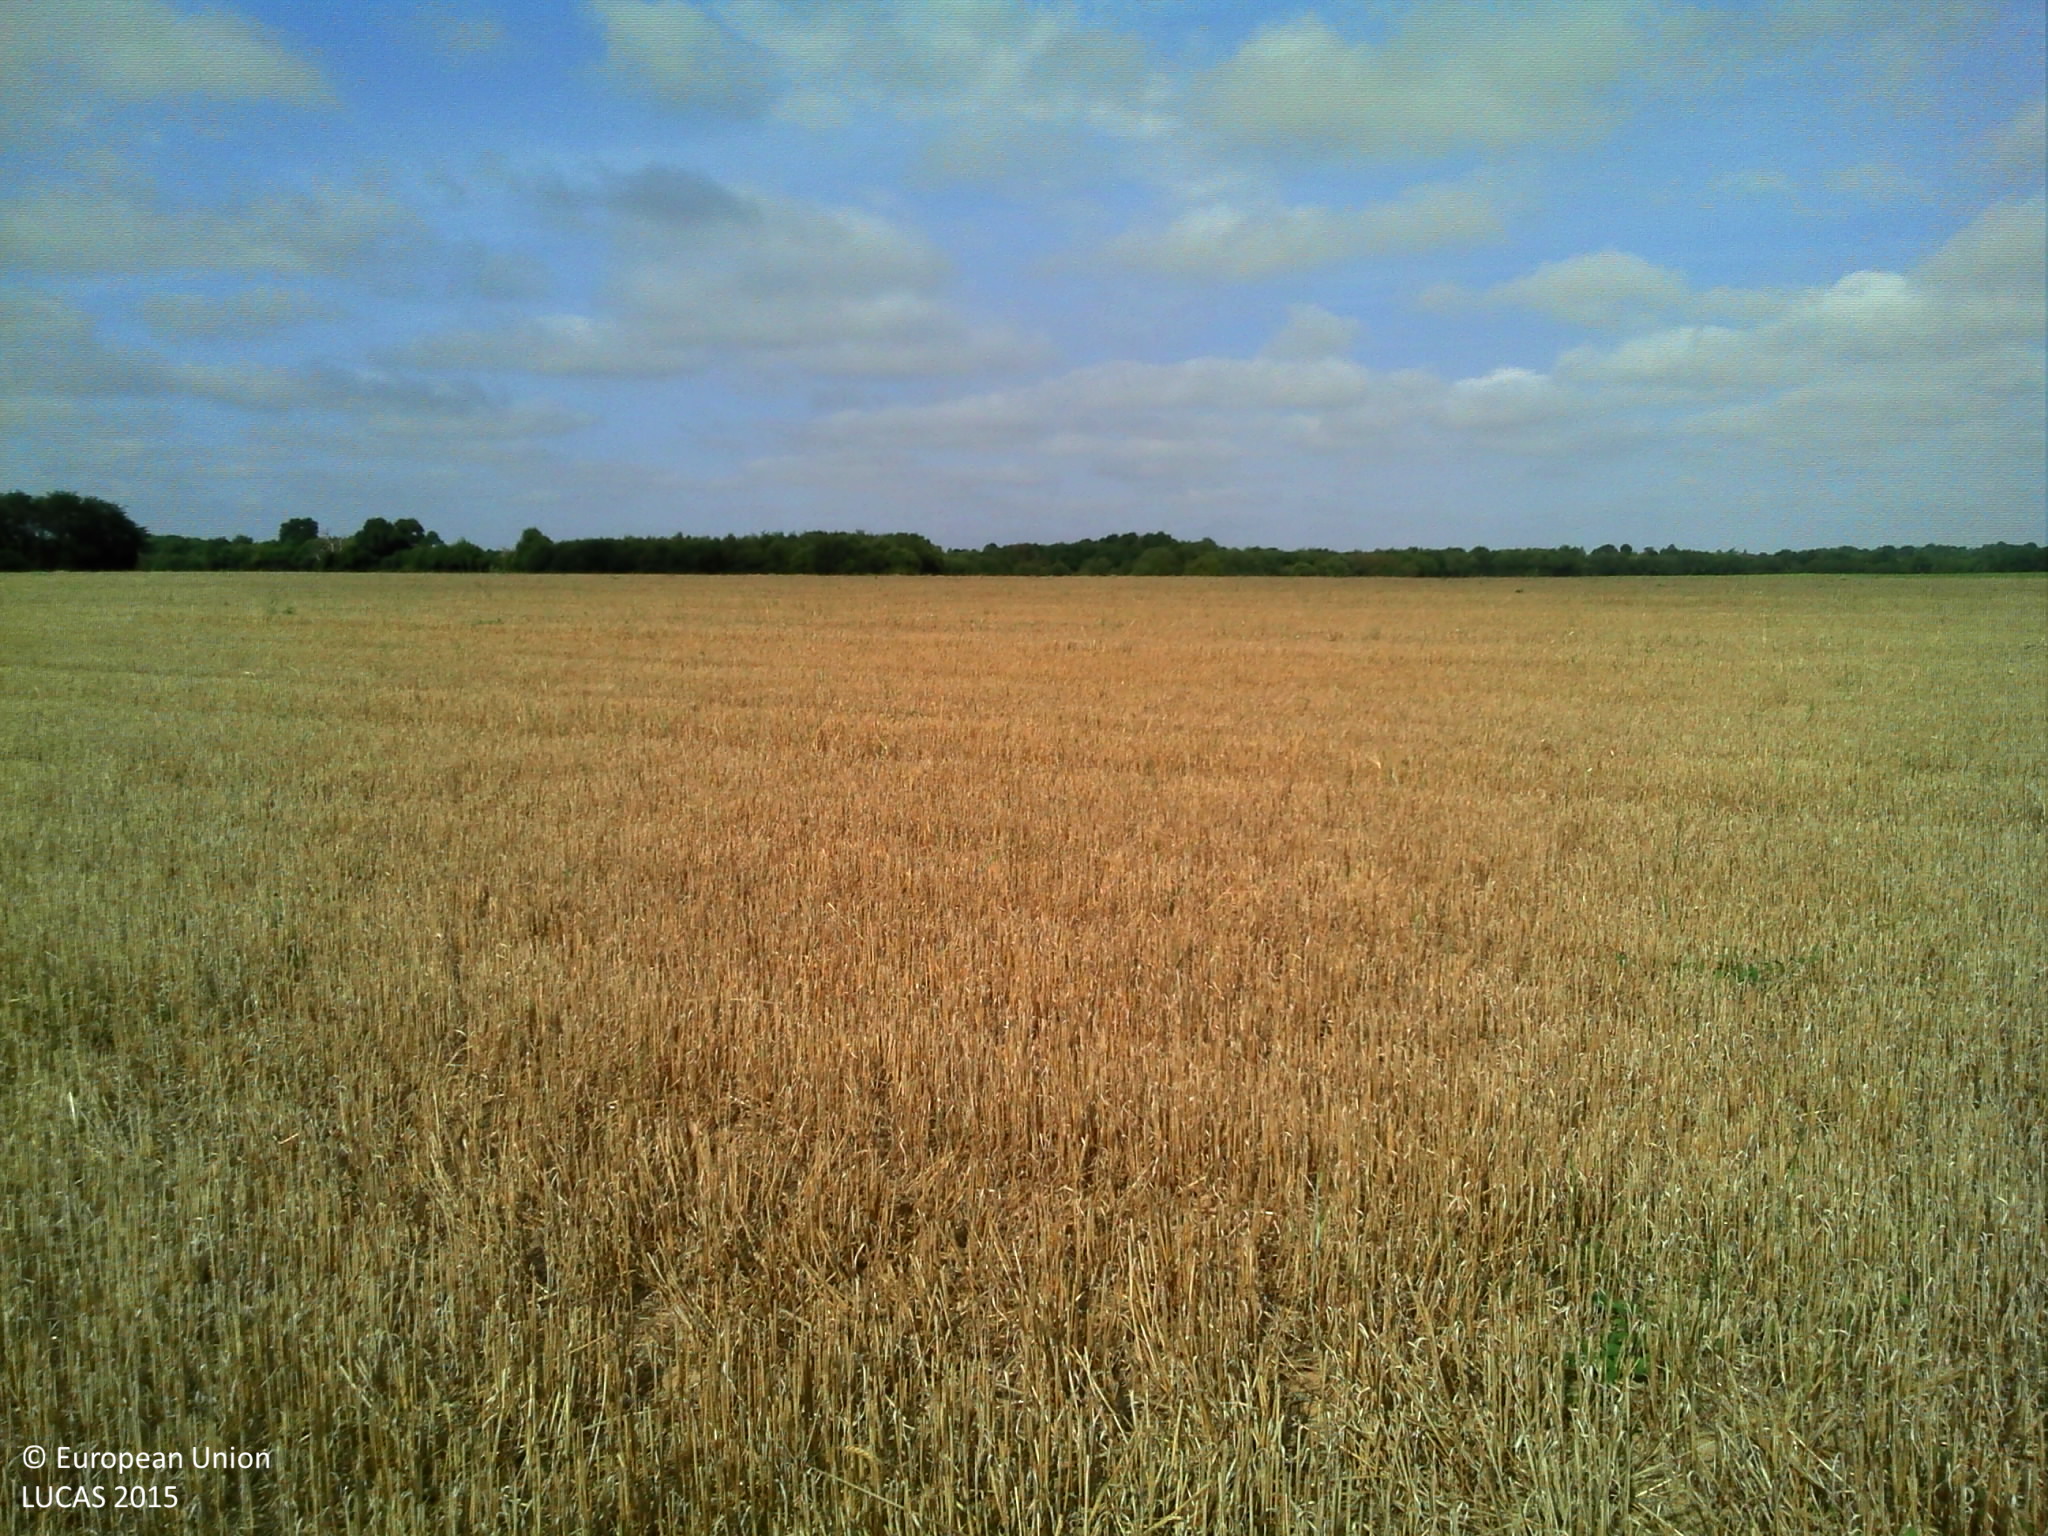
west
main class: Cropland
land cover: Common wheat
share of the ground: > 75 %
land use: Agriculture (excluding fallow land and kitchen gardens)
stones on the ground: 10 - 25 %
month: August
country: FR
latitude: 46.2664
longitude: 0.2373
